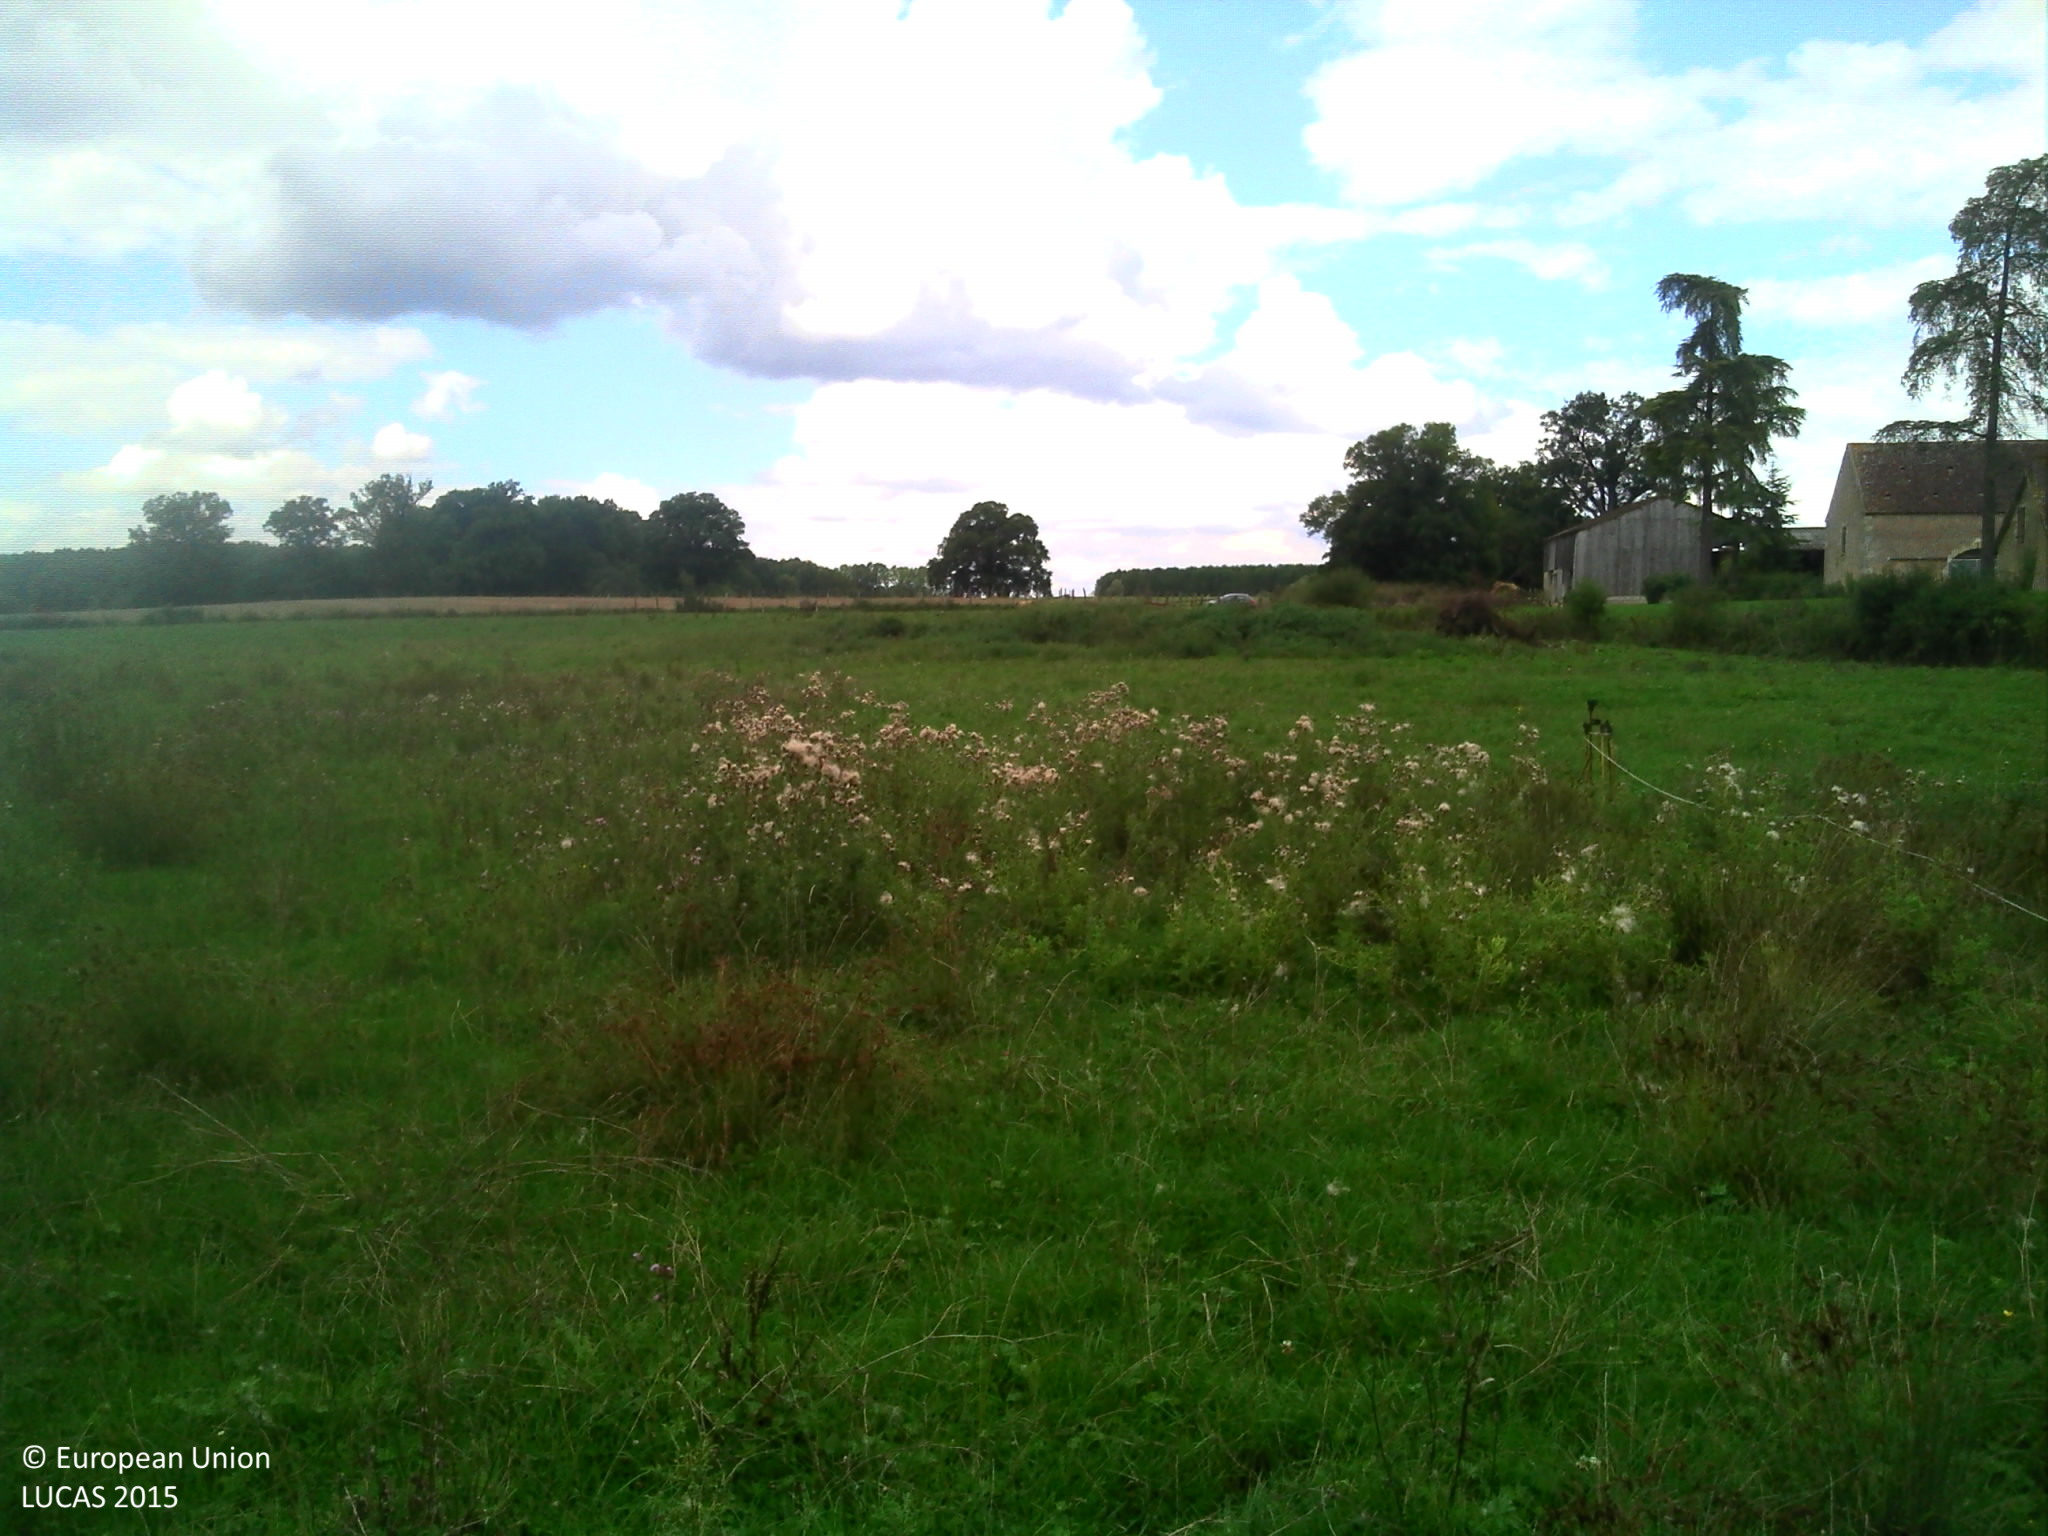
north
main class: Grassland
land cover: Grassland without tree/shrub cover
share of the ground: > 75 %
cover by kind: herbaceous plants 95 %, shrubs 5 %
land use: Agriculture (excluding fallow land and kitchen gardens)
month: September
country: FR
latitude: 48.3038
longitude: 0.5252
